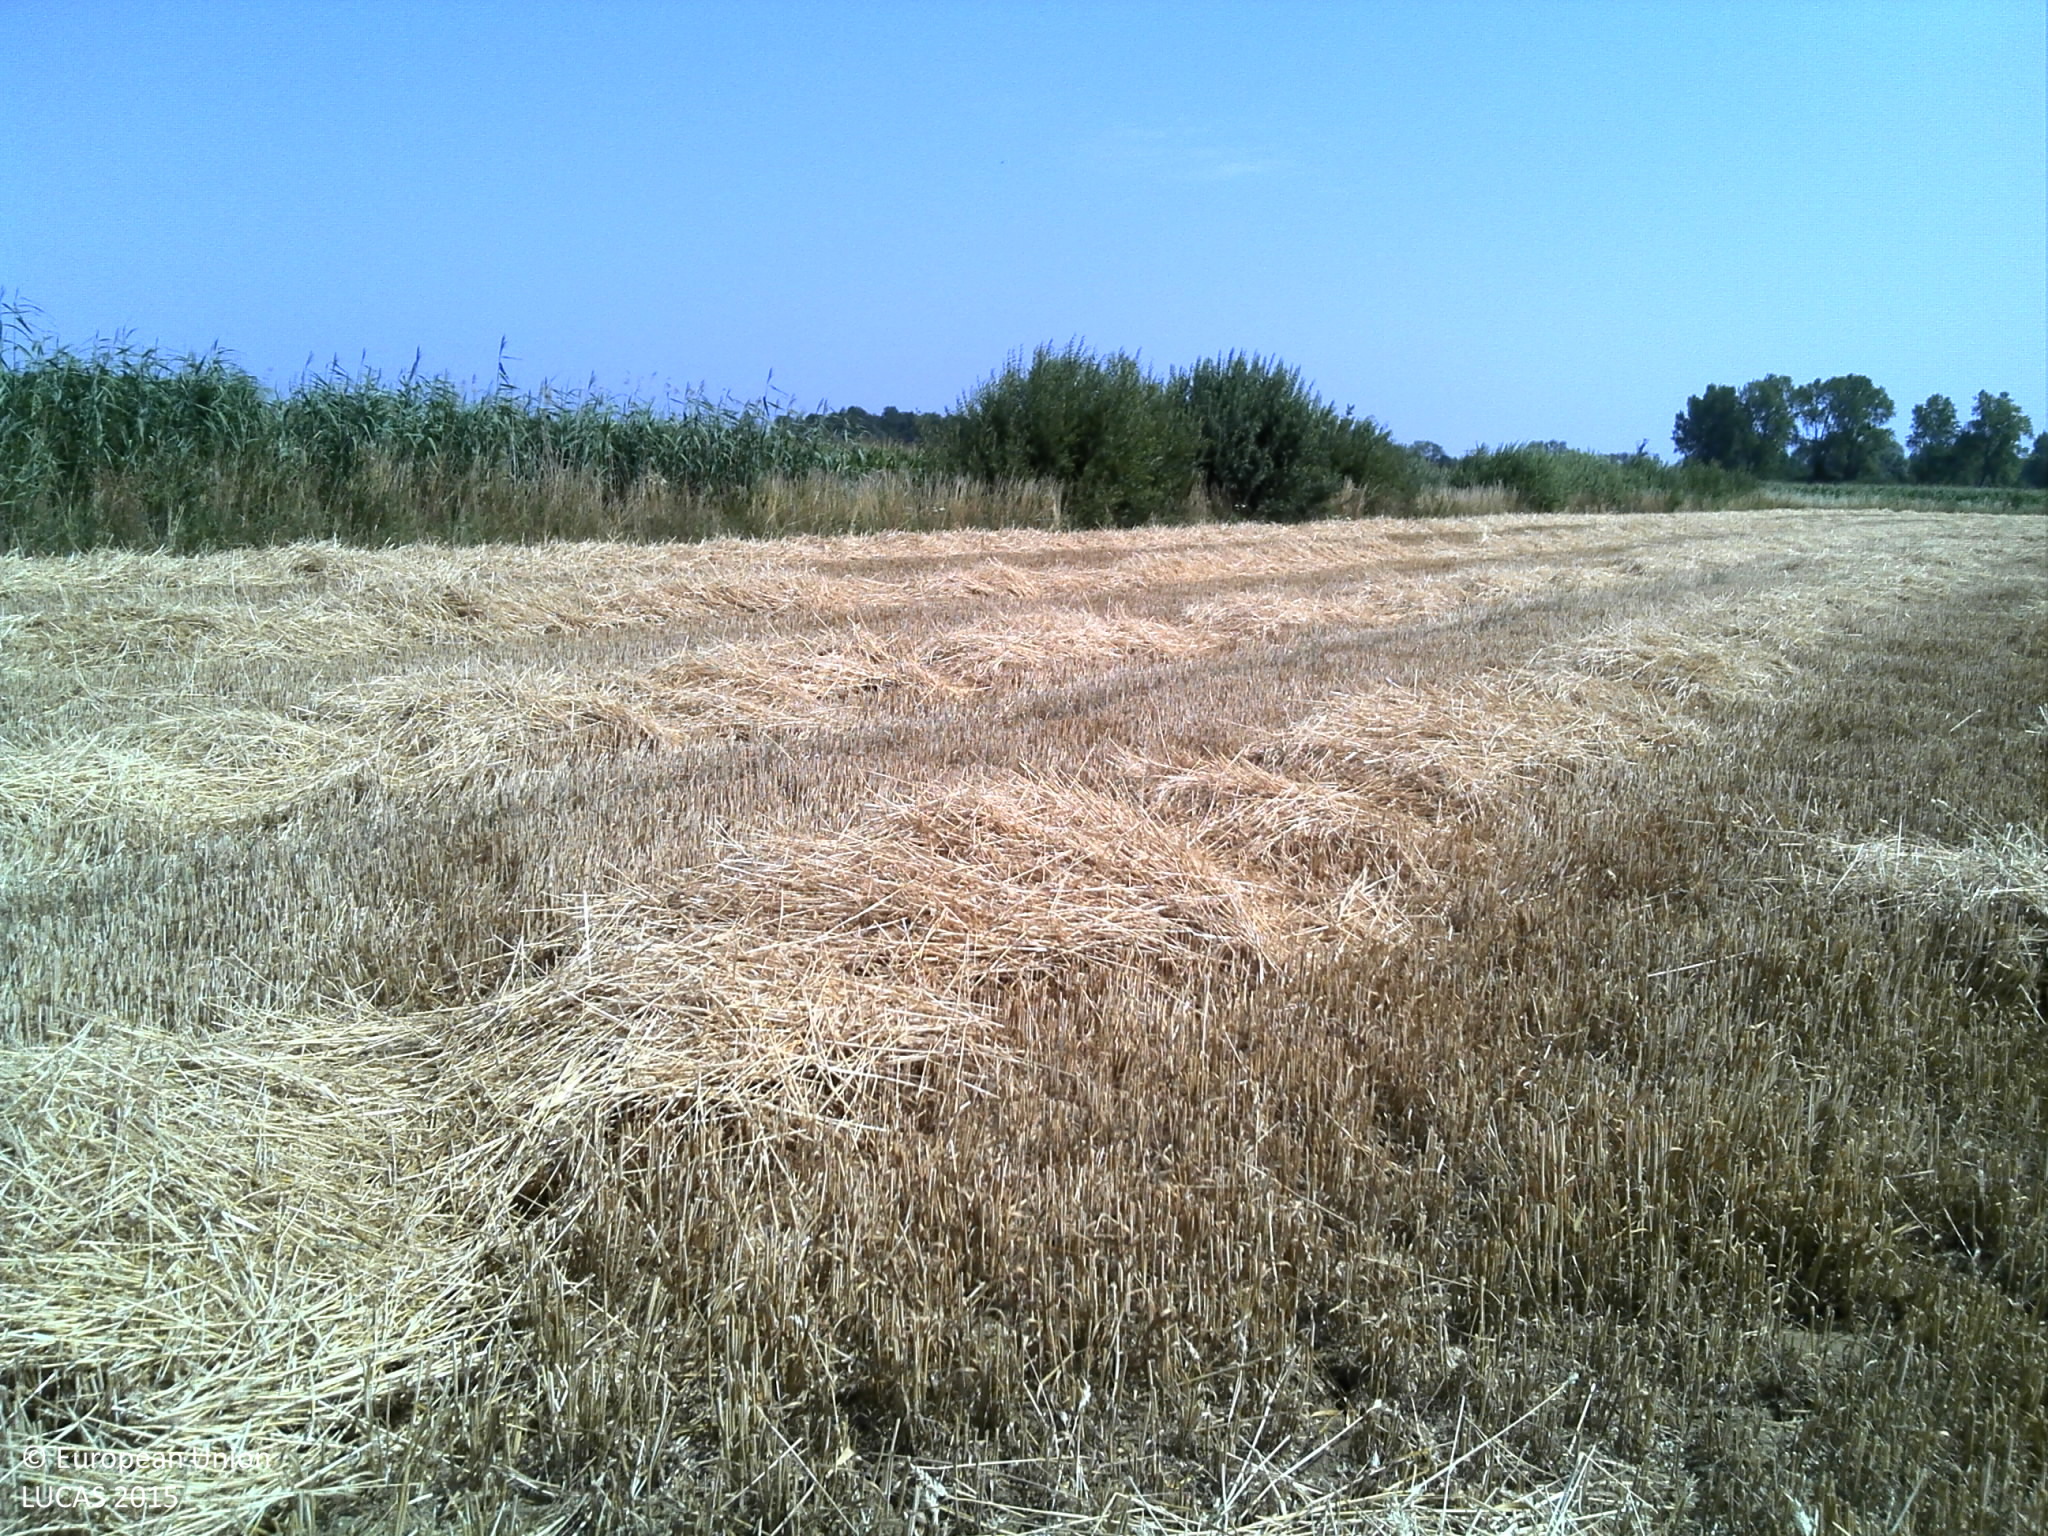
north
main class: Cropland
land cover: Common wheat
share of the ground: > 75 %
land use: Agriculture (excluding fallow land and kitchen gardens)
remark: Harvested field
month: July
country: FR
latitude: 48.7903
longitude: 4.8935
